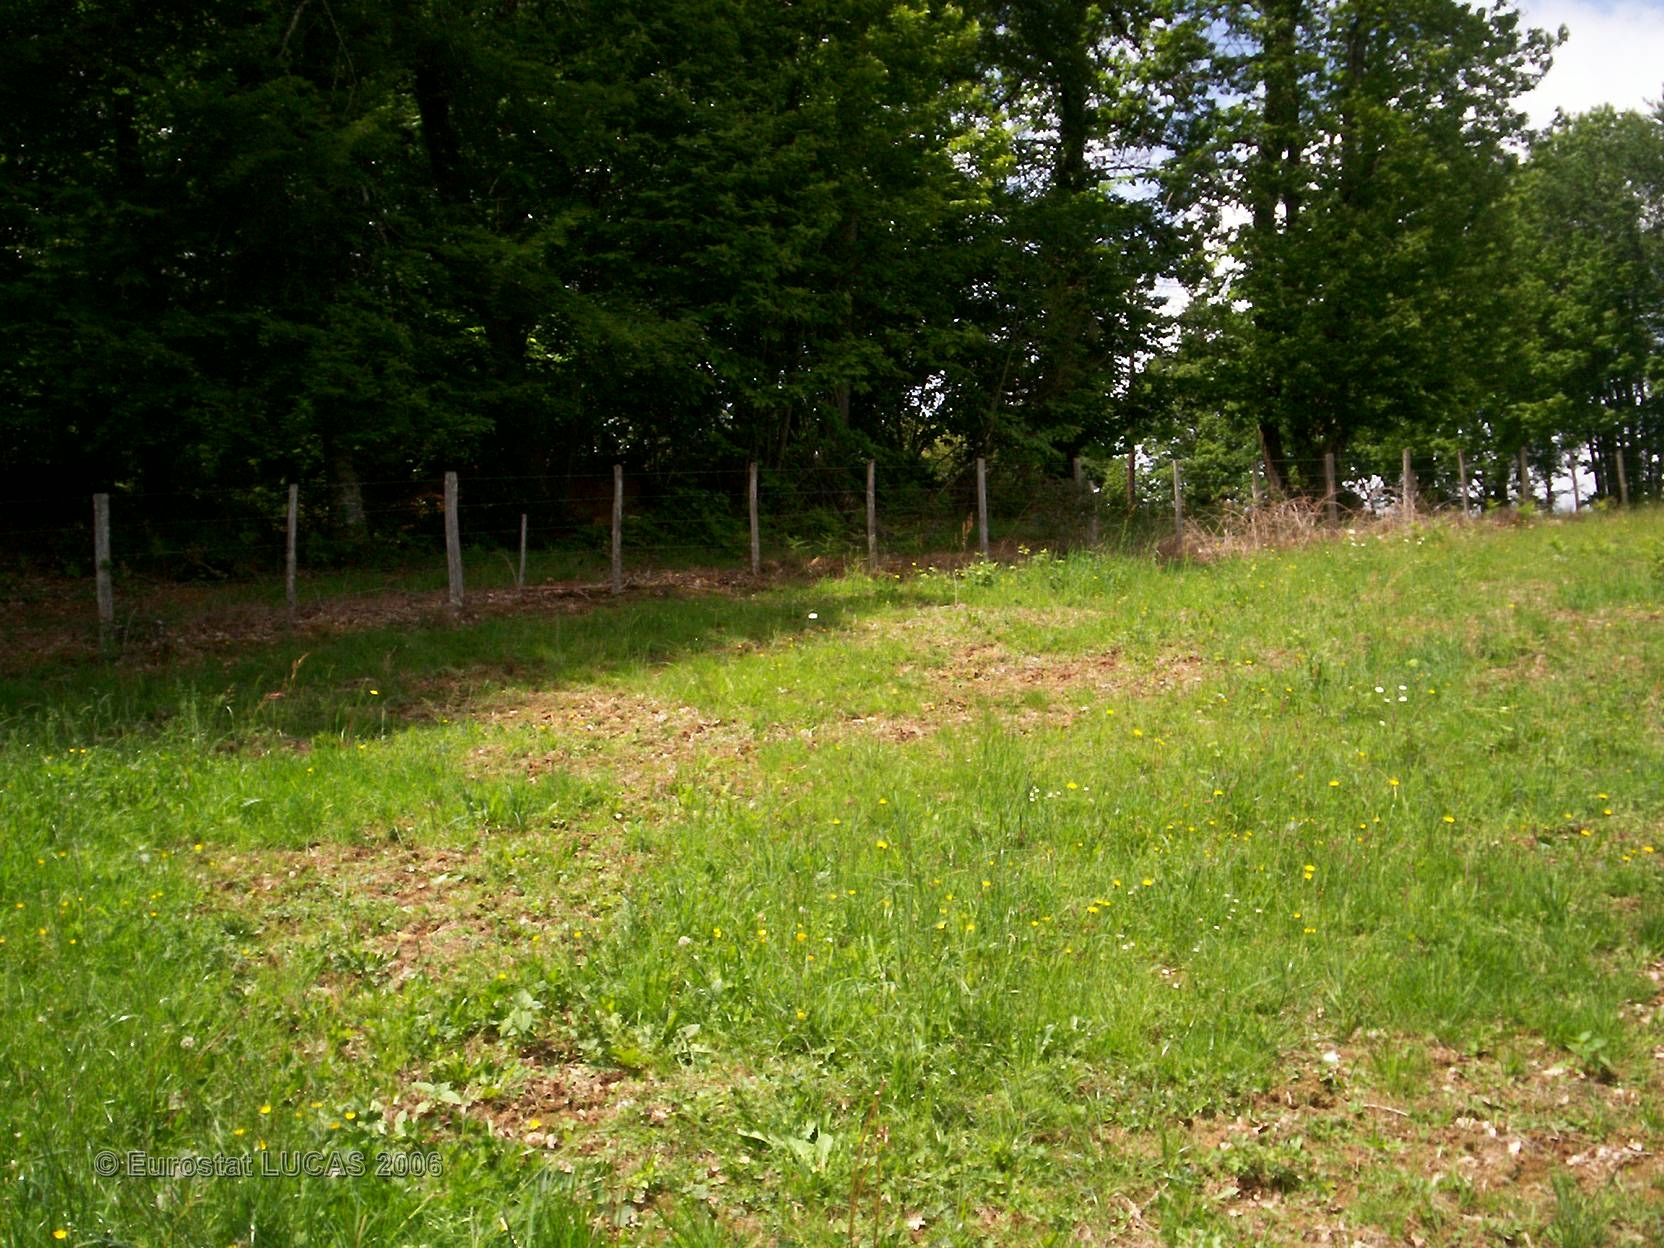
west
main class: Grassland
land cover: Grassland without tree/shrub cover
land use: Agriculture (excluding fallow land and kitchen gardens)
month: May
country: FR
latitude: 45.5836
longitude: 1.5732
